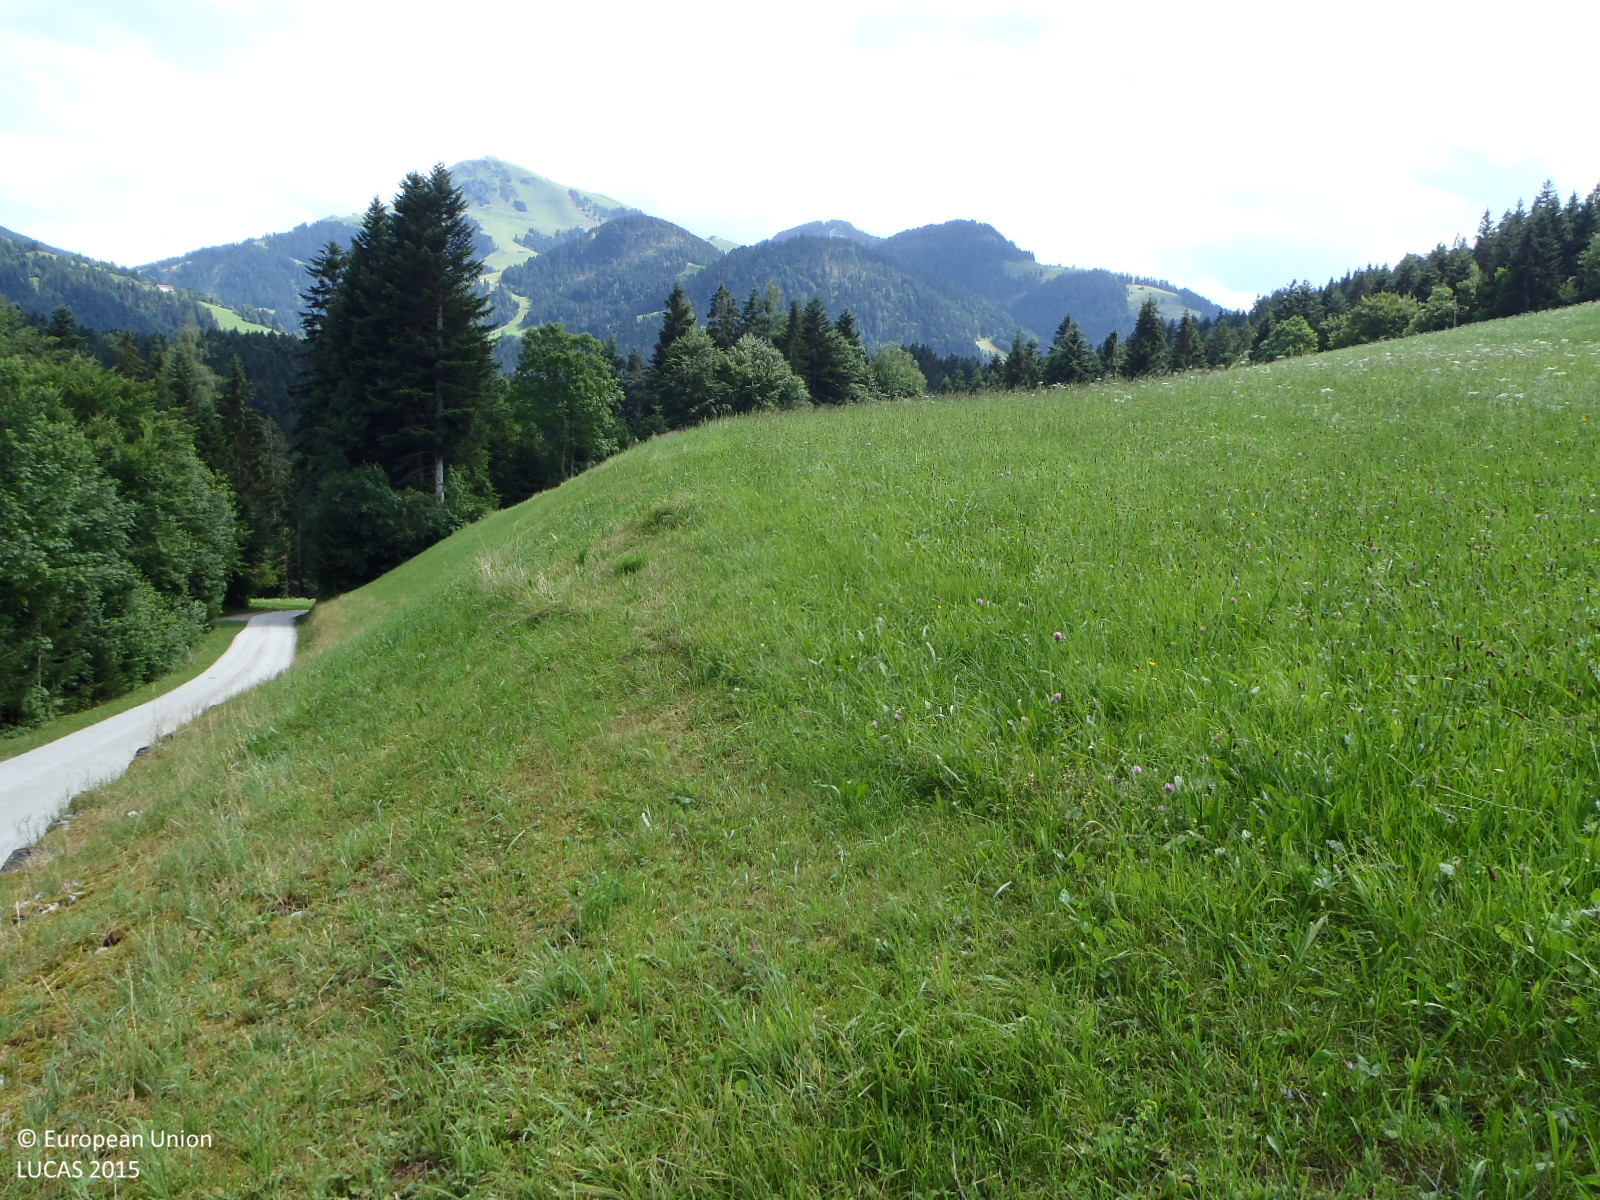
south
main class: Grassland
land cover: Grassland without tree/shrub cover
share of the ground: > 75 %
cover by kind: herbaceous plants 100 %
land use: Agriculture (excluding fallow land and kitchen gardens)
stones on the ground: < 10 %
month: July
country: AT
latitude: 47.5177
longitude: 12.1896
